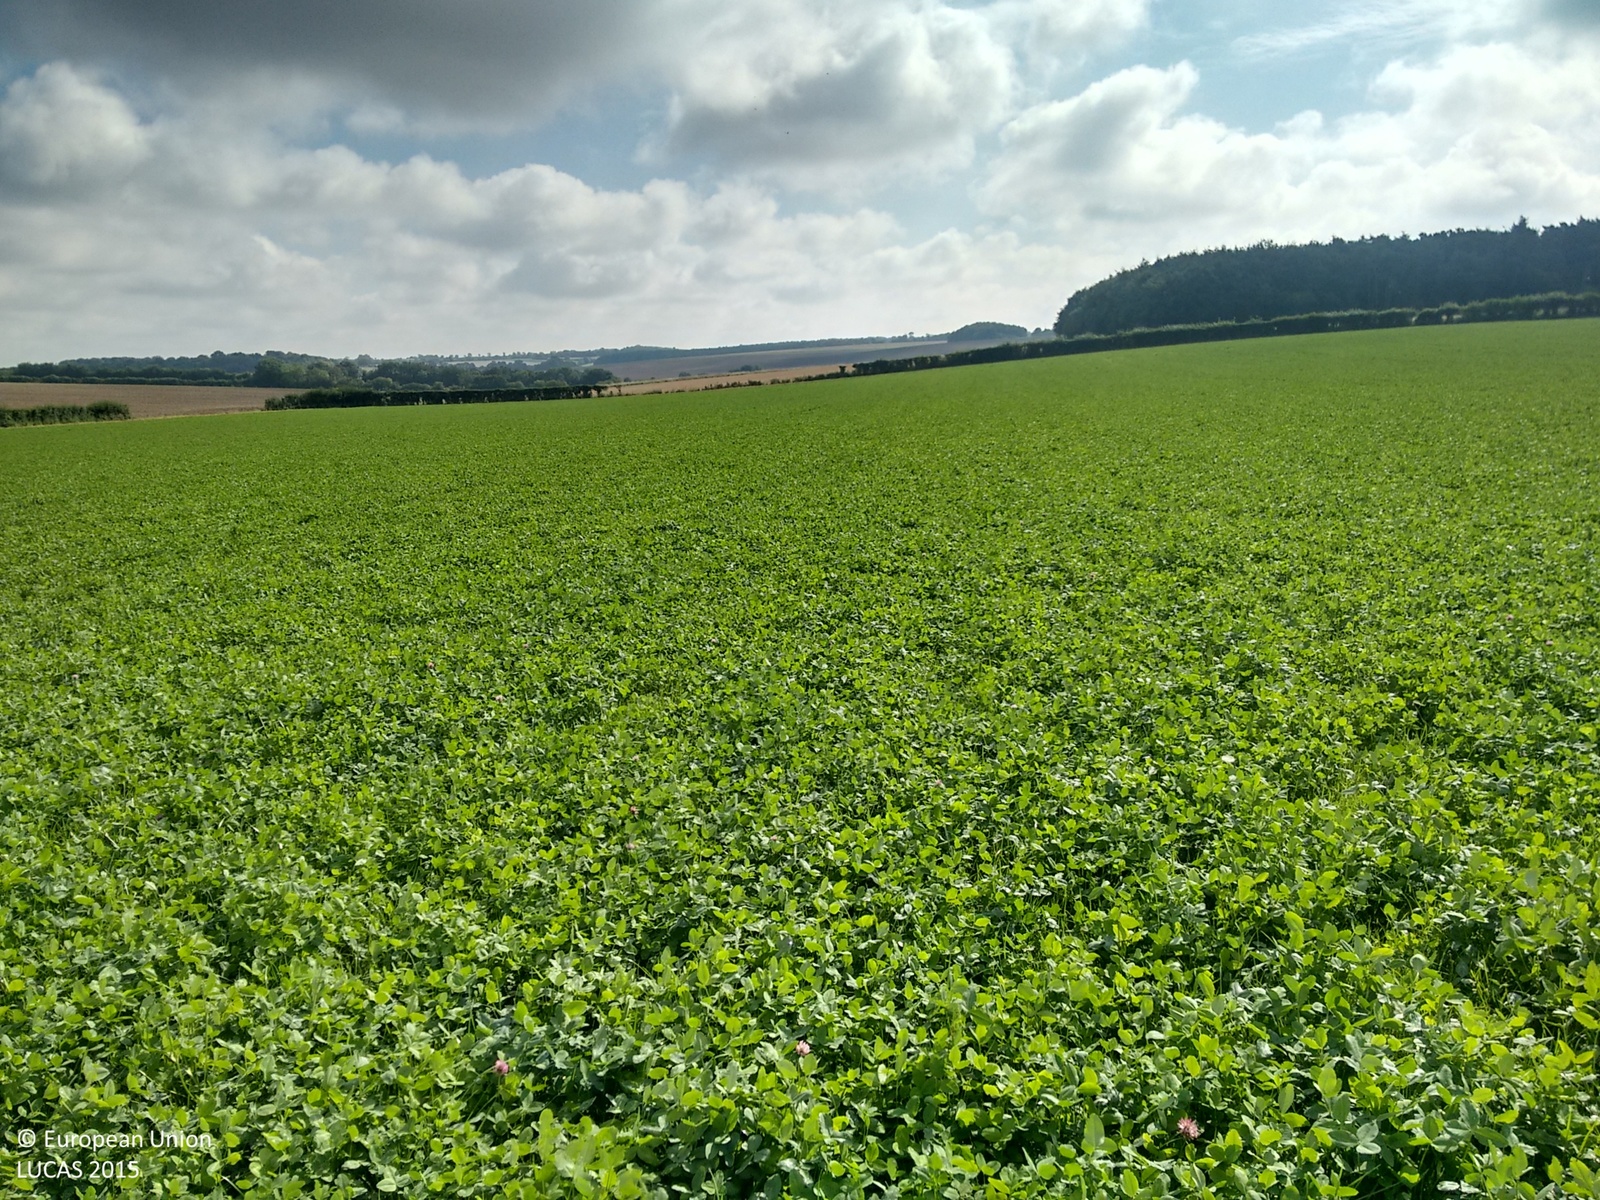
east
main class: Cropland
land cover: Clovers
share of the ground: > 75 %
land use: Agriculture (excluding fallow land and kitchen gardens)
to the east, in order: Clovers; Grass margins; Barley
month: September
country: GB
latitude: 52.2132
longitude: 0.5031
